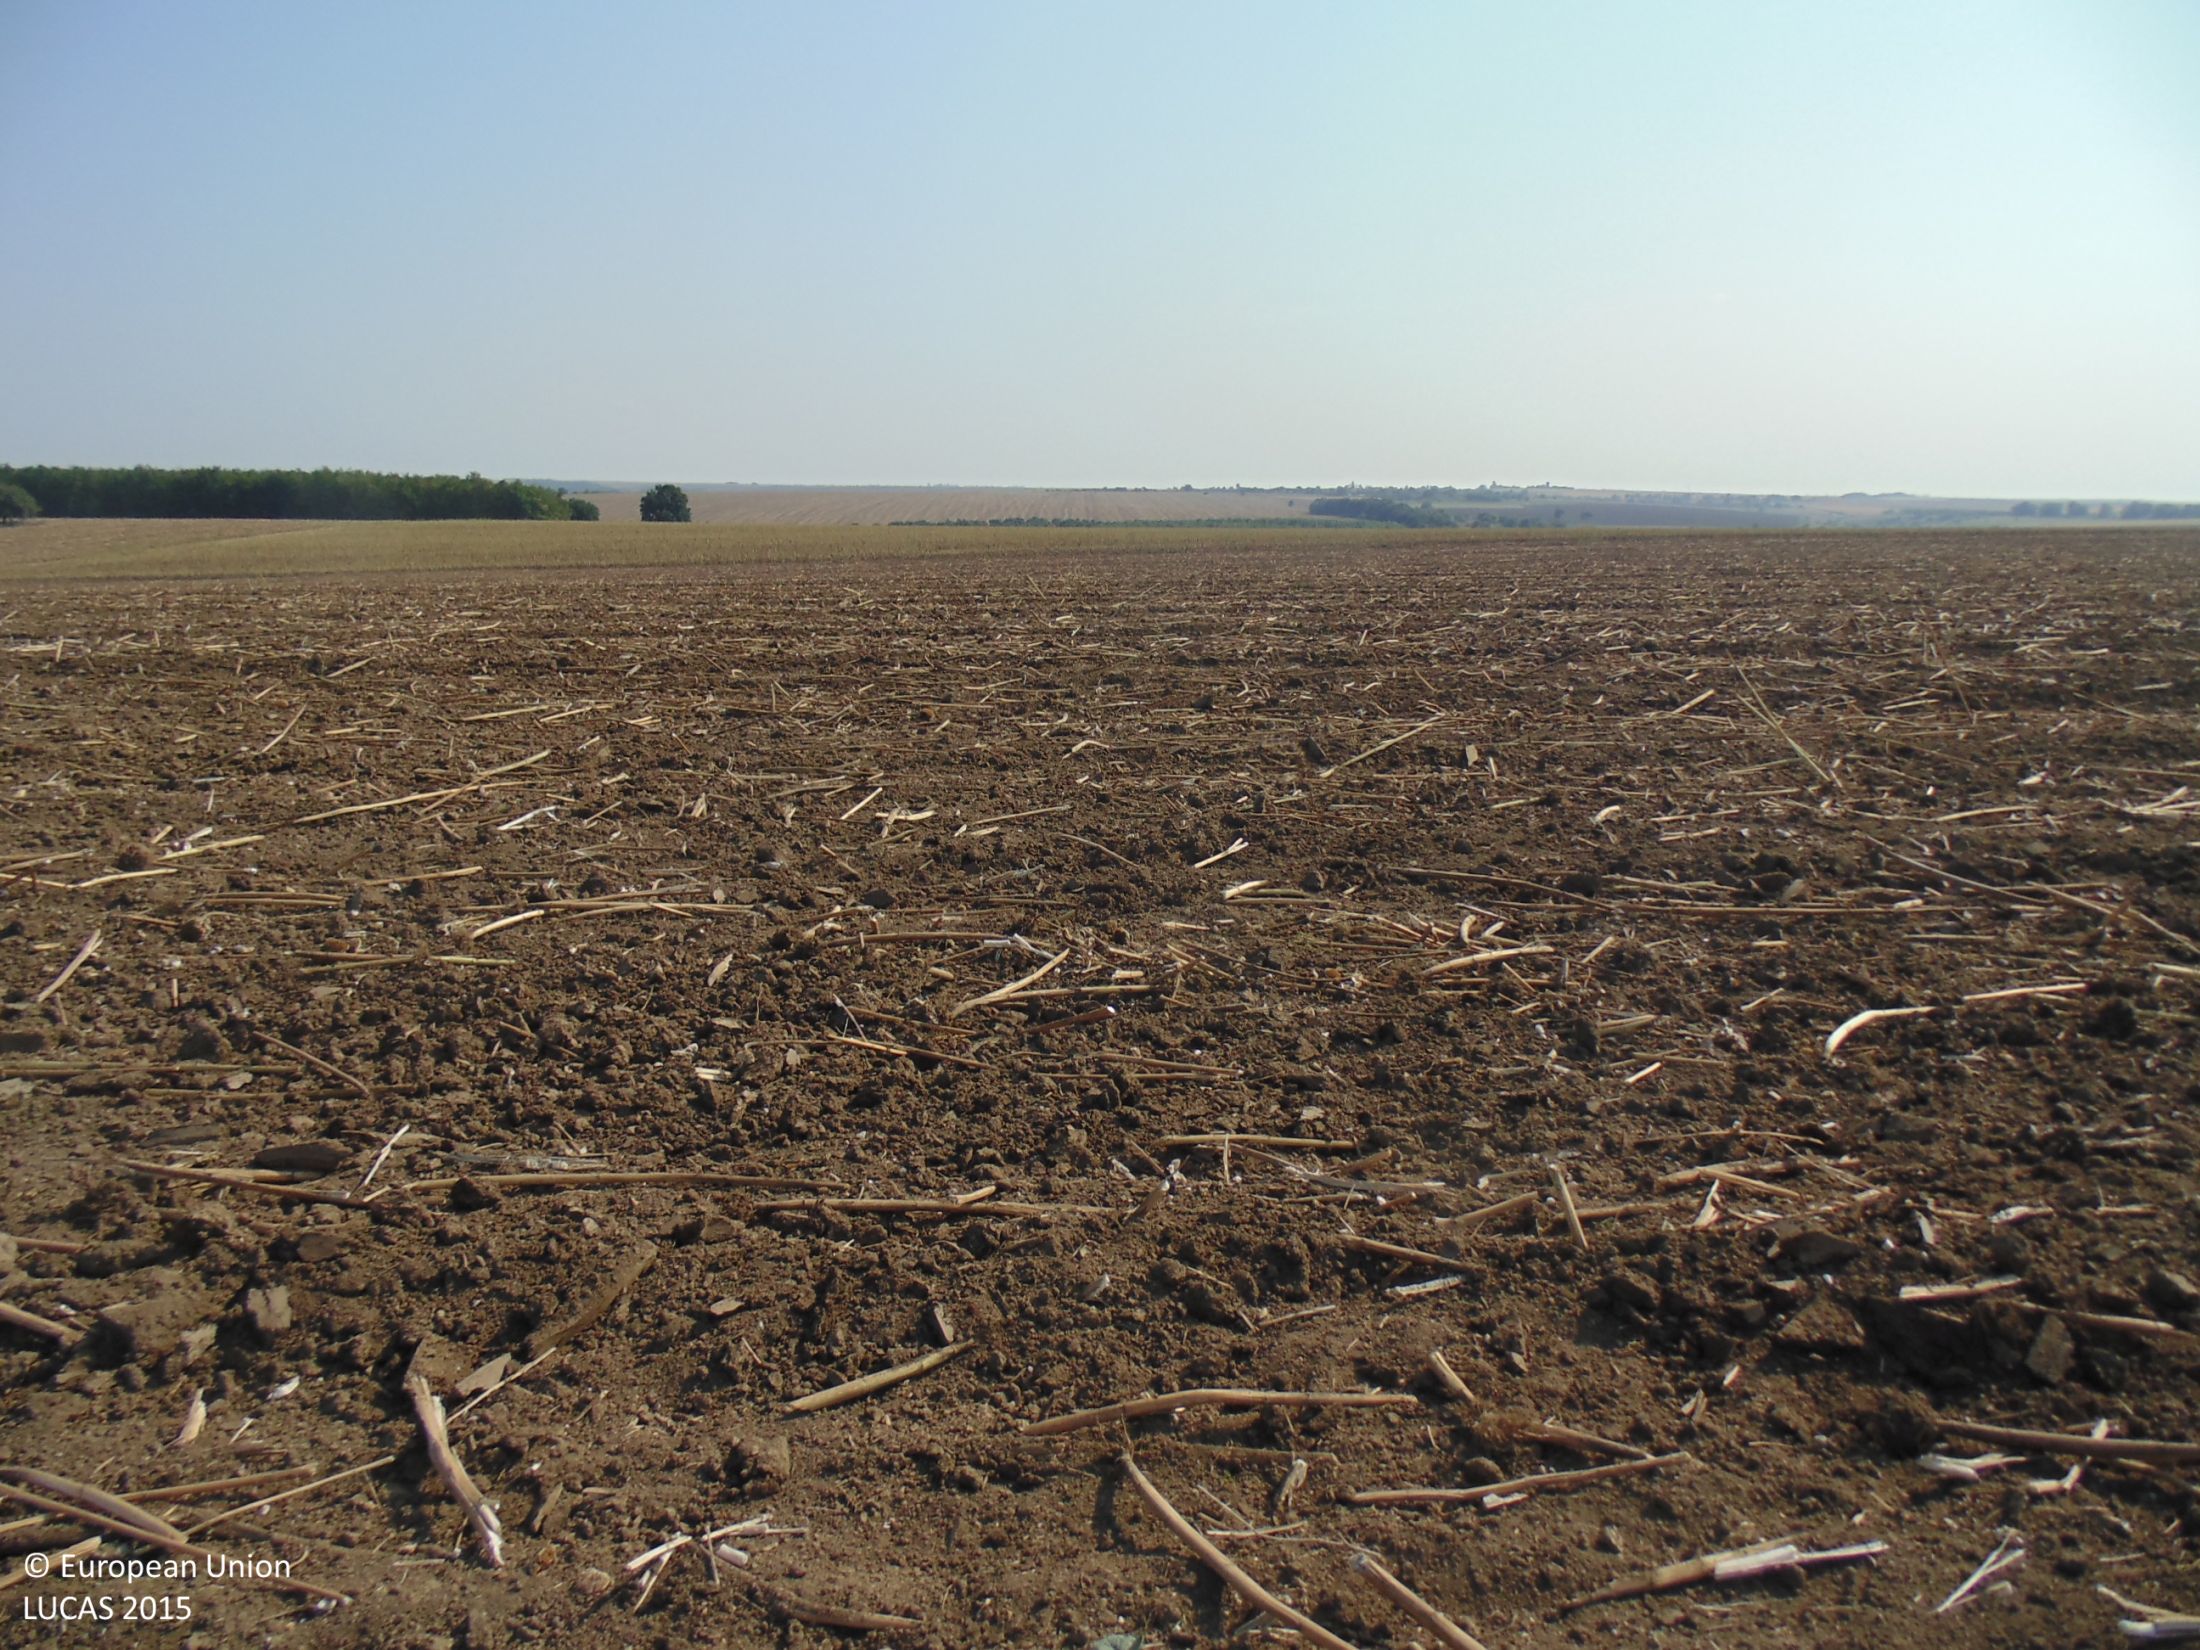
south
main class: Cropland
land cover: Sunflower
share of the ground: < 10 %
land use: Agriculture (excluding fallow land and kitchen gardens)
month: September
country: BG
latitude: 43.8009
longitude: 26.8852
